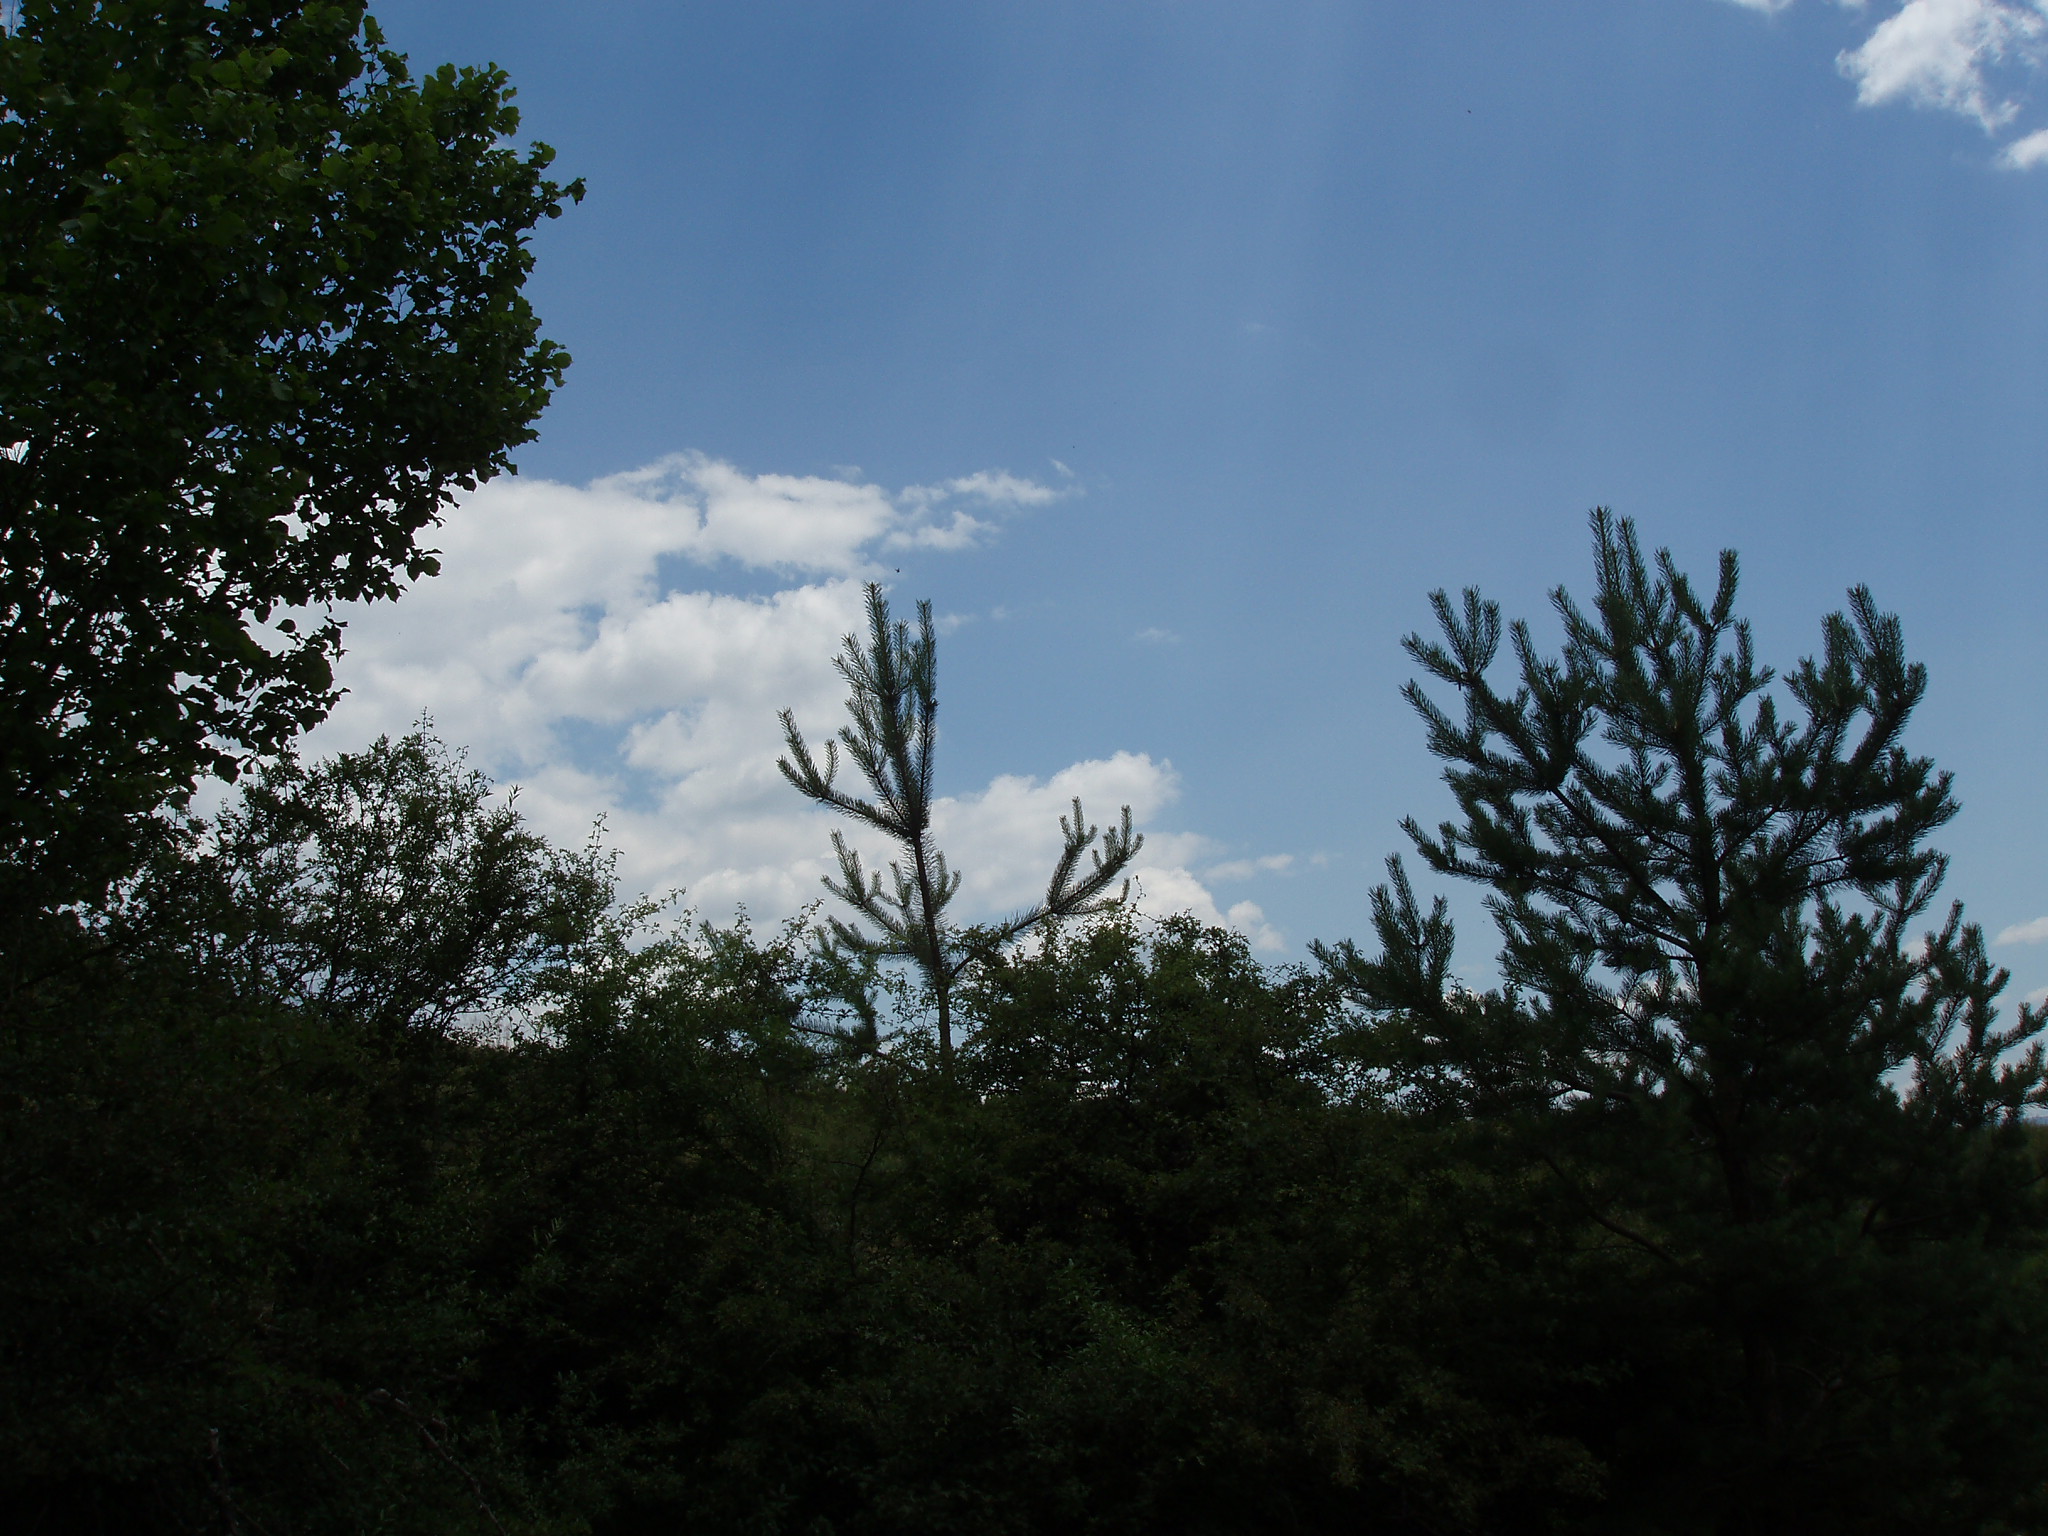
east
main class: Grassland
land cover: Grassland with sparse tree/shrub cover
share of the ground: > 75 %
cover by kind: herbaceous plants 90 %, broadleaved forest trees 5 %, shrubs 5 %
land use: Agriculture (excluding fallow land and kitchen gardens)
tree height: > 5 m
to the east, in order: Grassland with sparse tree/shrub cover; Broadleaved woodland; Grassland with sparse tree/shrub cover; Permanent industrial crops; Grassland with sparse tree/shrub cover; Groves; Tracks; Grassland without tree/shrub cover
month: July
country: BG
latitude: 41.9108
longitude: 23.4951
